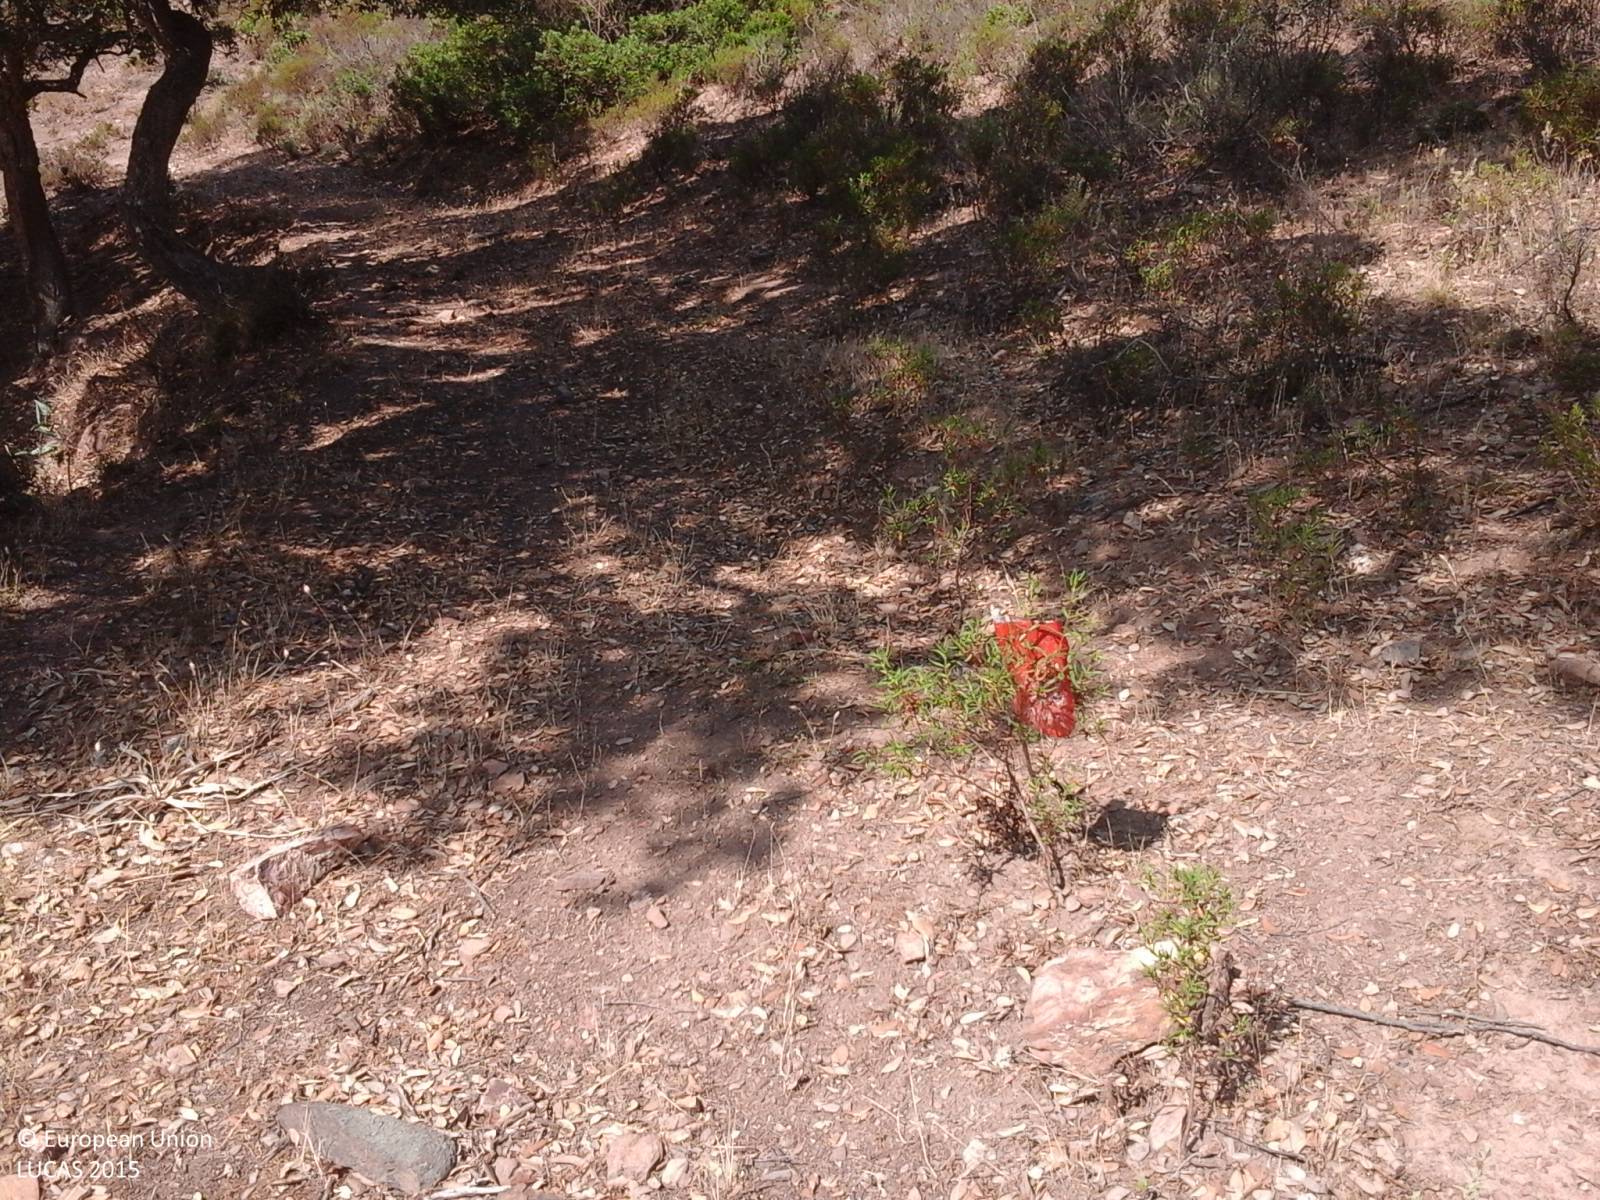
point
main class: Shrubland
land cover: Shrubland with sparse tree cover
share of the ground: > 75 %
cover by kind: shrubs 90 %, broadleaved forest trees 5 %, herbaceous plants 5 %
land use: Agriculture (excluding fallow land and kitchen gardens)
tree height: < 5 m
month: July
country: IT
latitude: 39.4402
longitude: 8.4638
